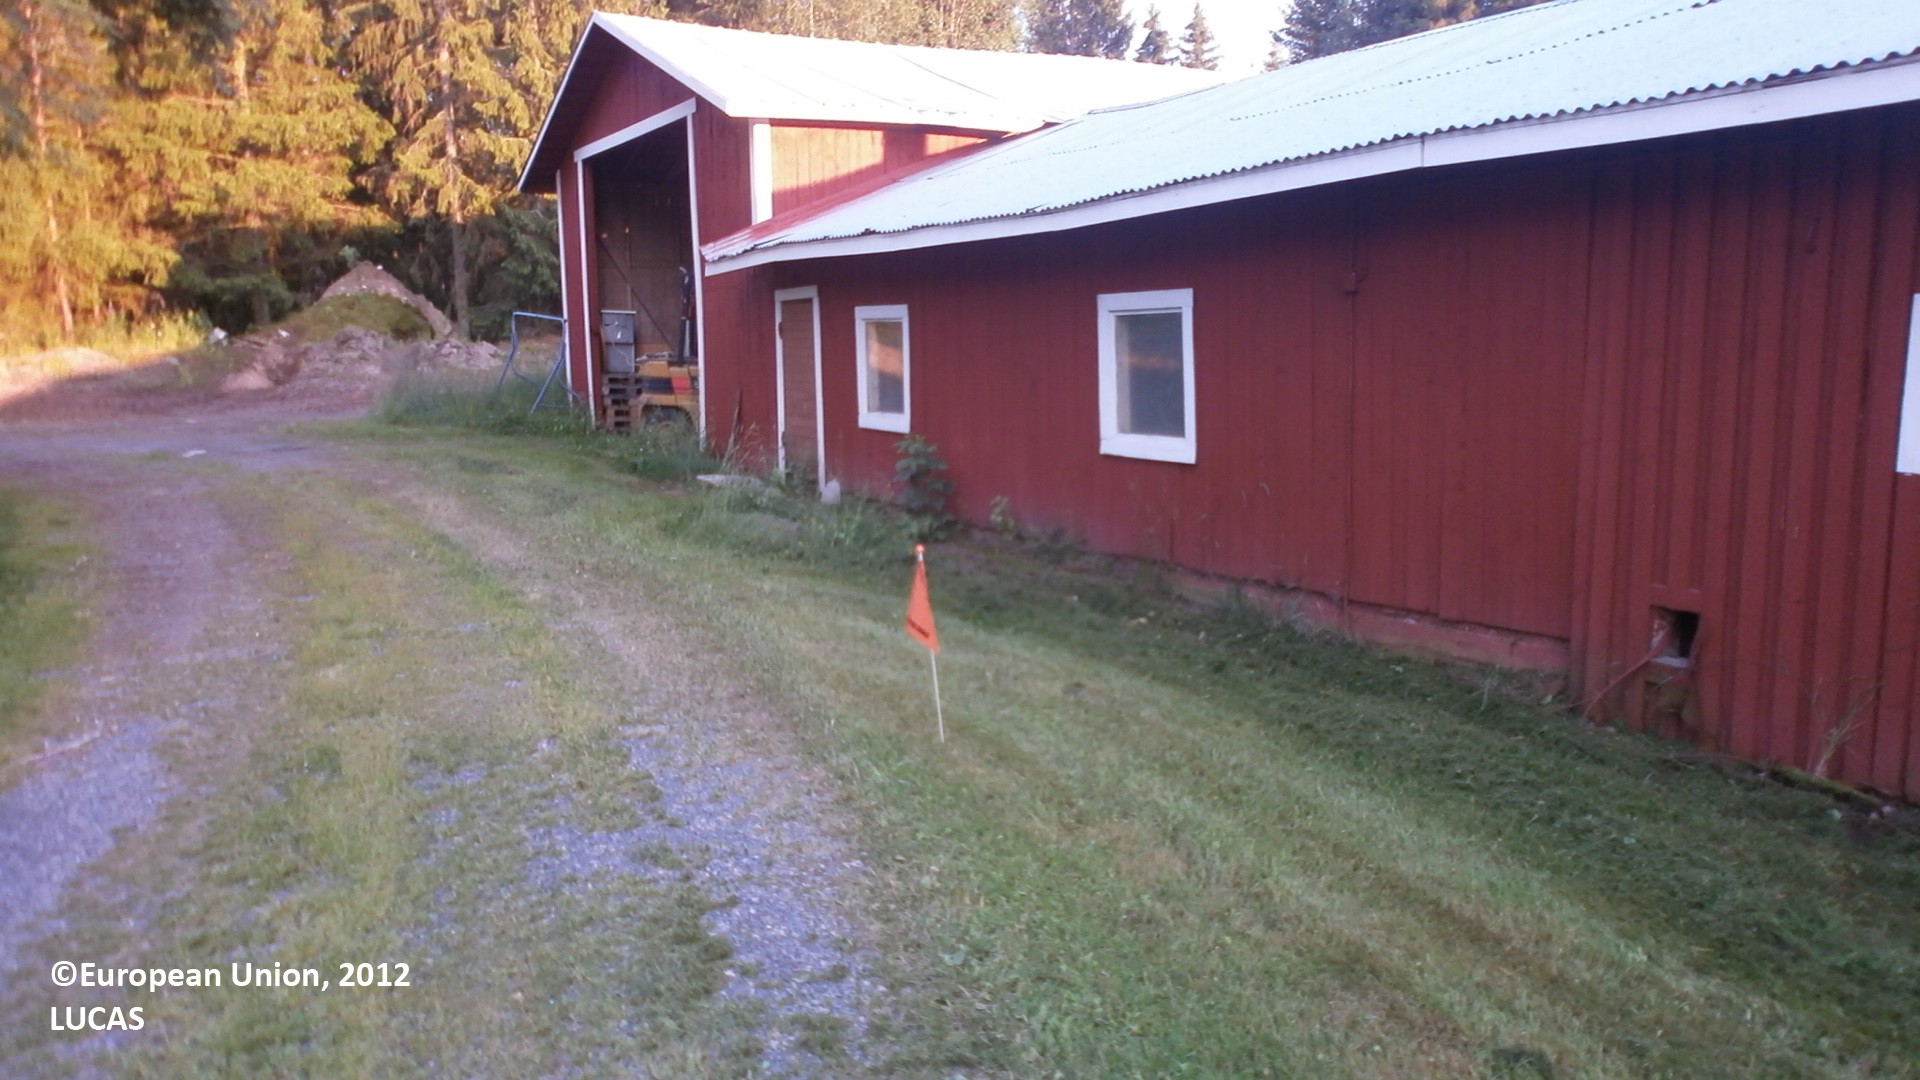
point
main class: Grassland
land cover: Grassland without tree/shrub cover
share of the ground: > 75 %
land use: Residential
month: July
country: FI
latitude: 64.1225
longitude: 24.0080
